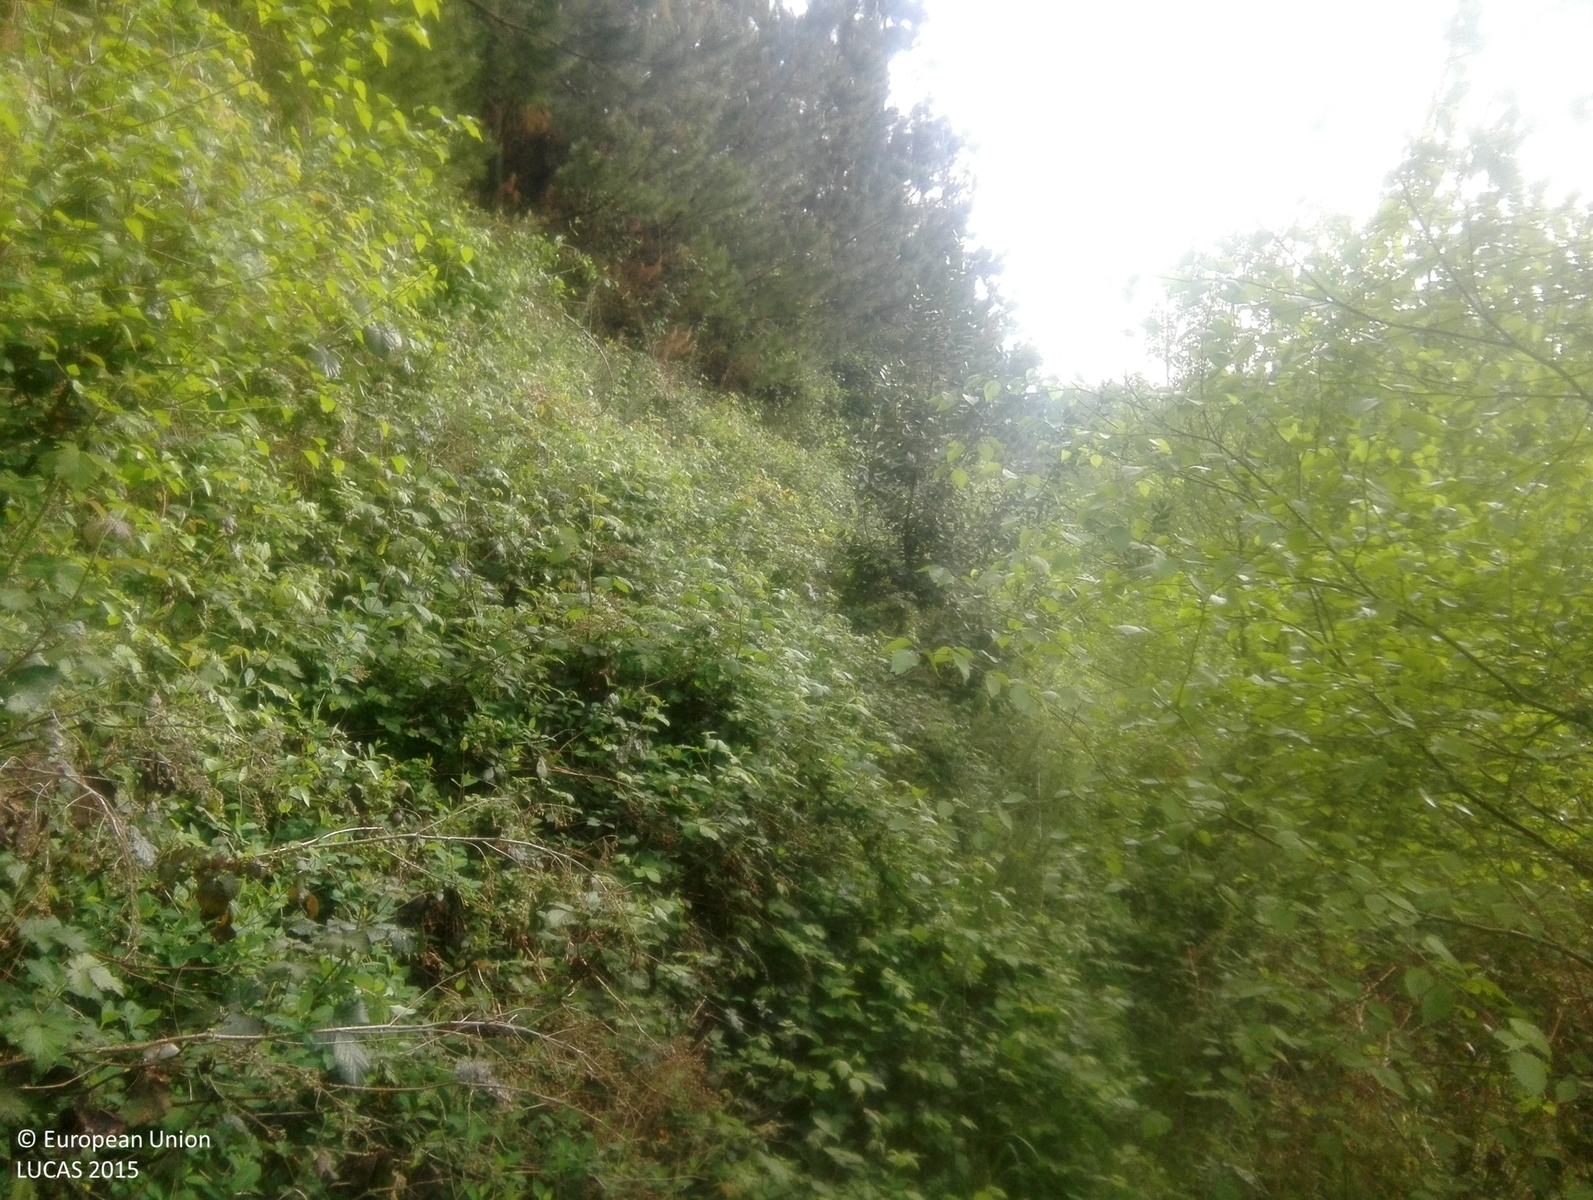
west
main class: Woodland
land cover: Broadleaved woodland
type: thermophilous deciduous forest
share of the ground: > 75 %
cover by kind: broadleaved forest trees 100 %
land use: Forestry
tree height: > 5 m
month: April
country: ES
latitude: 43.3976
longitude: -7.0953
